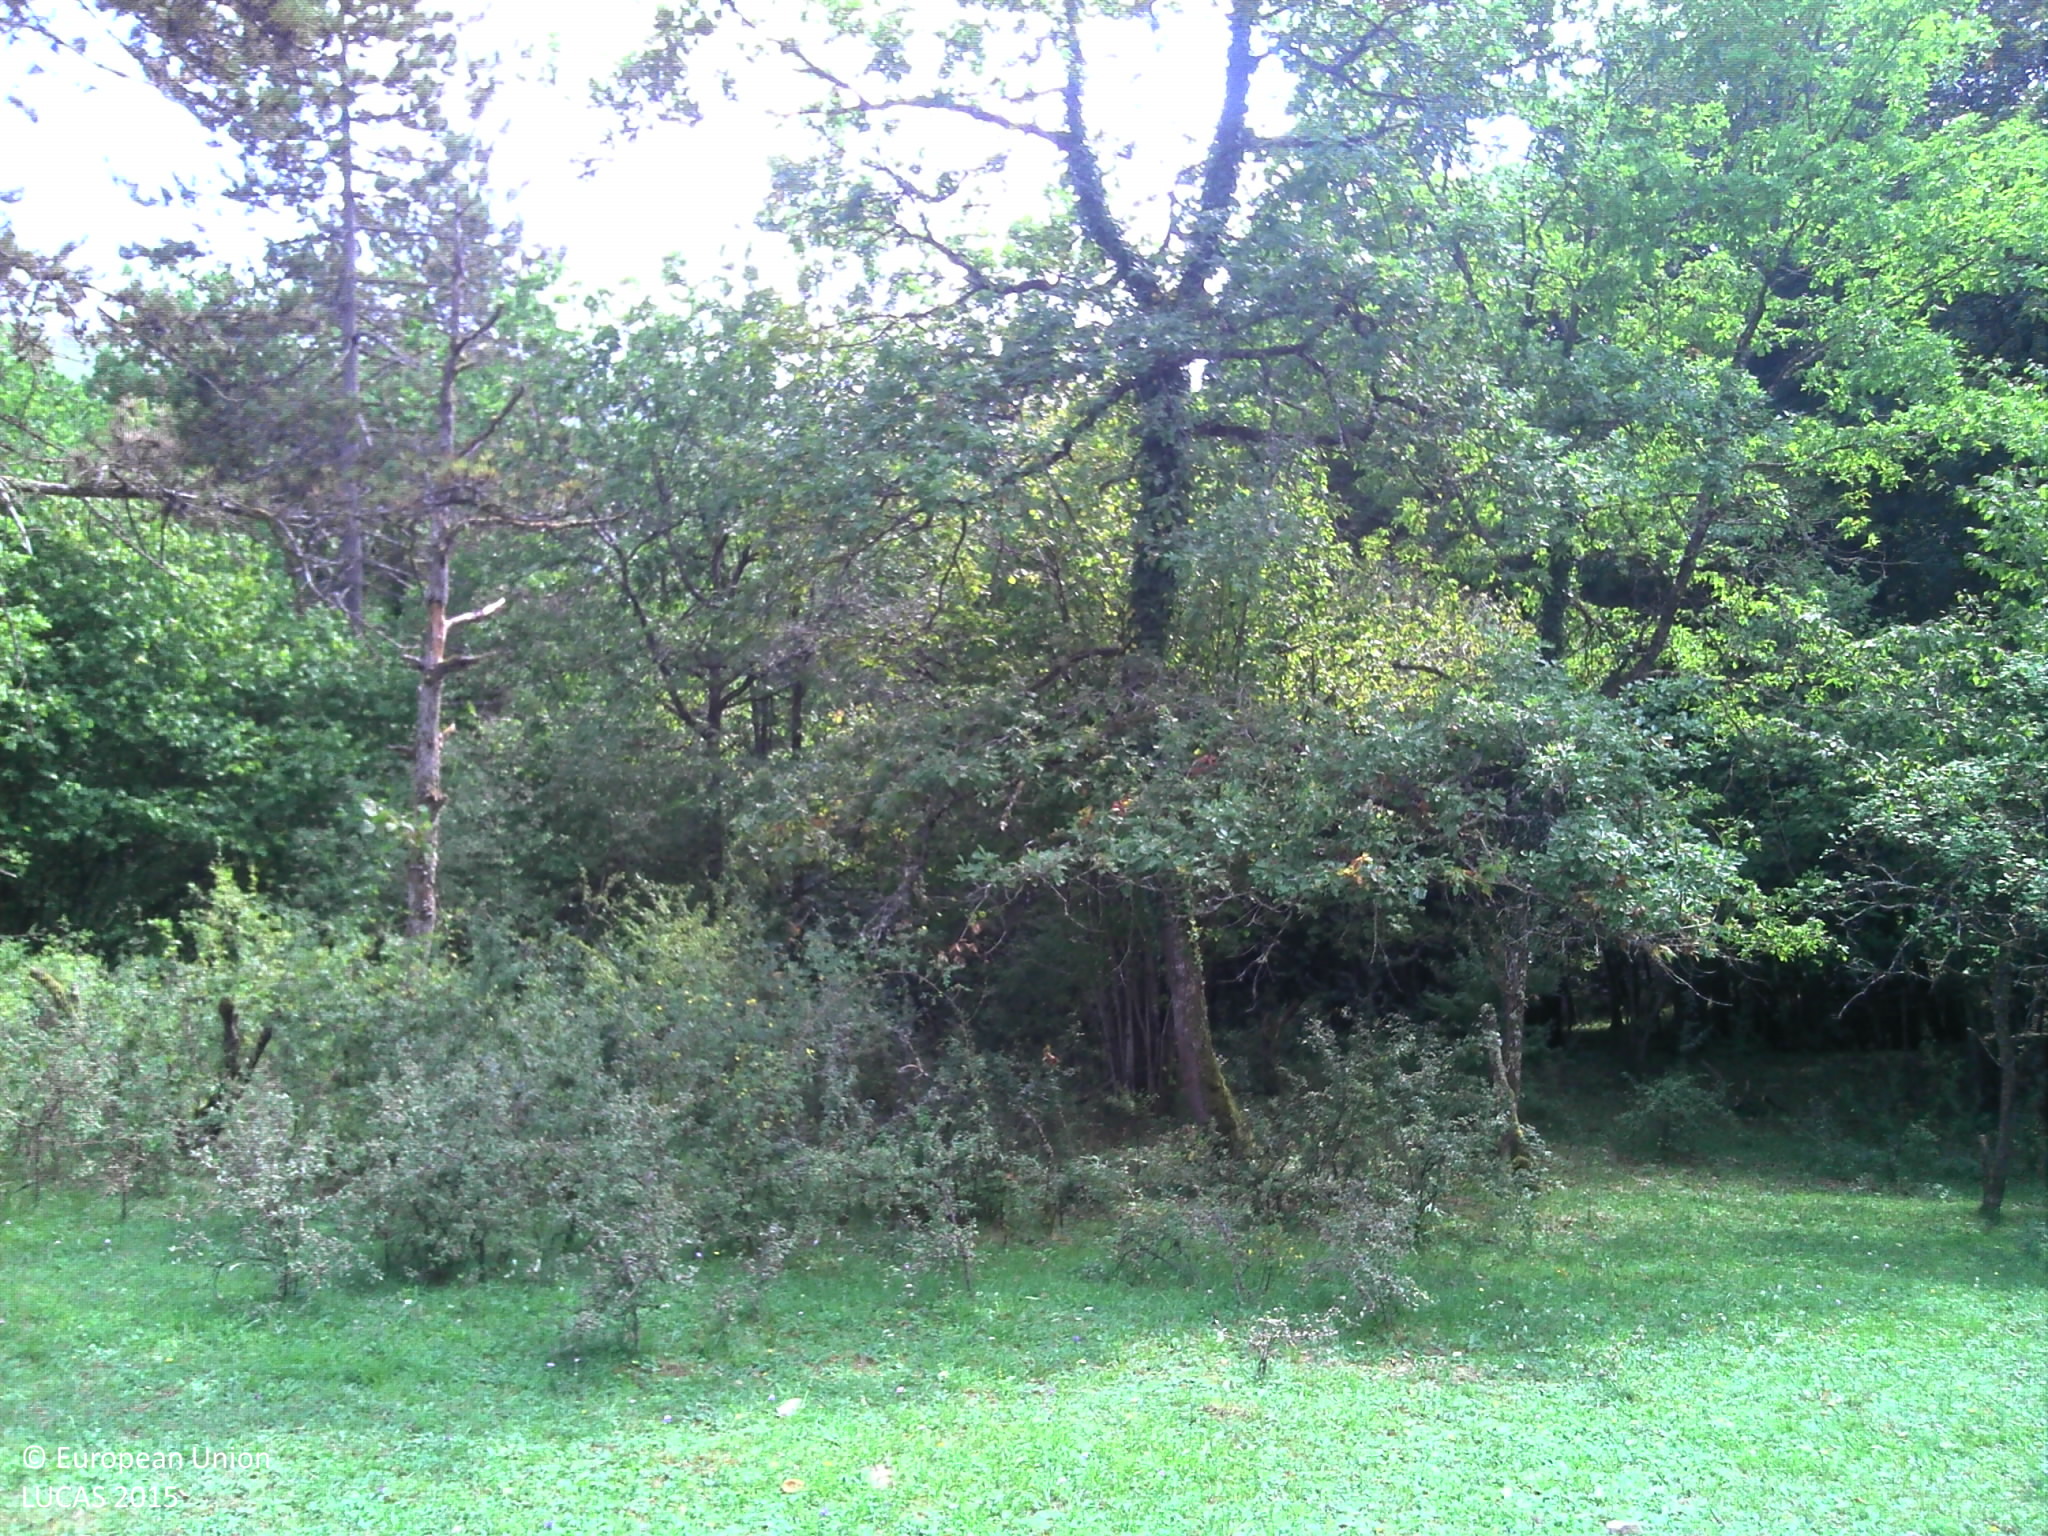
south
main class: Grassland
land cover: Grassland without tree/shrub cover
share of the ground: > 75 %
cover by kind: herbaceous plants 100 %
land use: Agriculture (excluding fallow land and kitchen gardens)
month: August
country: FR
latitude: 47.2318
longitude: 4.7300
